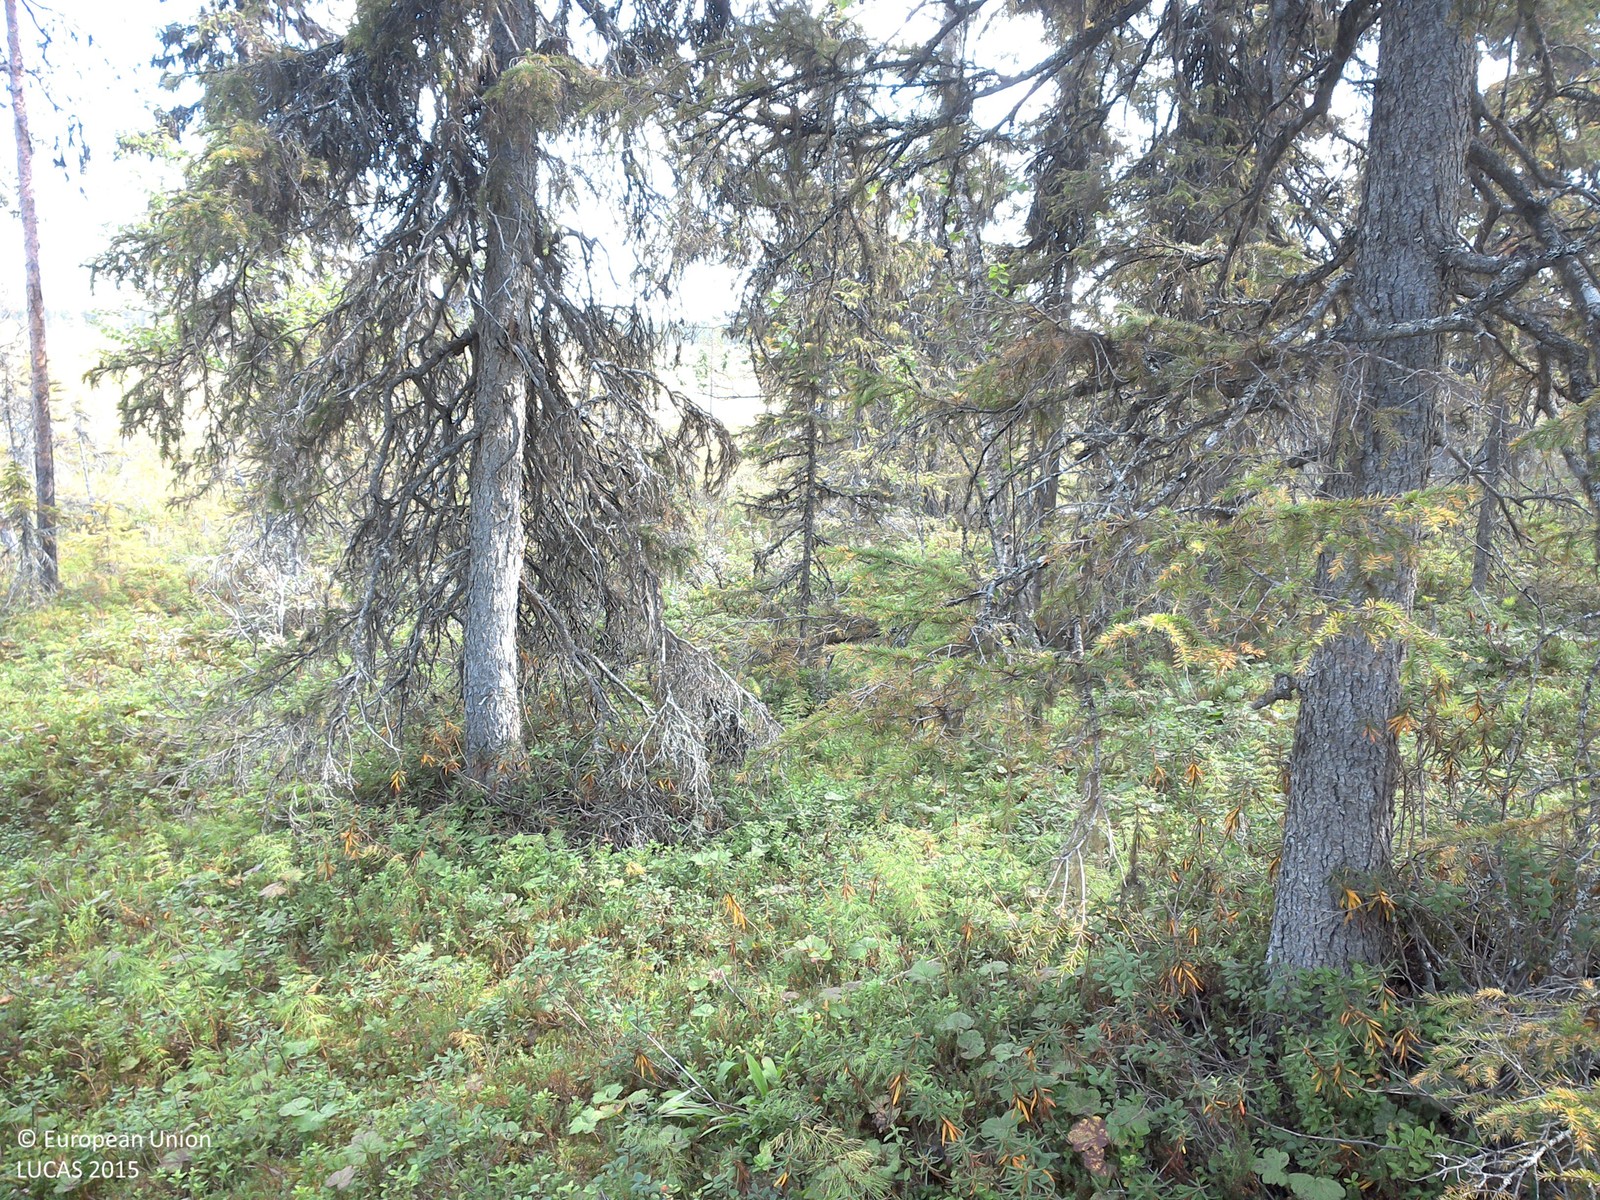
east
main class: Woodland
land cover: Spruce dominated coniferous woodland
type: boreal forest
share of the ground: 25 - 50 %
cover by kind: shrubs 40 %, coniferous forest trees 20 %, herbaceous plants 20 %, lichens and mosses 15 %, broadleaved forest trees 5 %
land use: Forestry
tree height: > 5 m
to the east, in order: Spruce dominated coniferous woodland; Shrubland with sparse tree cover; Peatbogs; Shrubland with sparse tree cover; Peatbogs
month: August
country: SE
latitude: 67.3180
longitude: 21.9699
